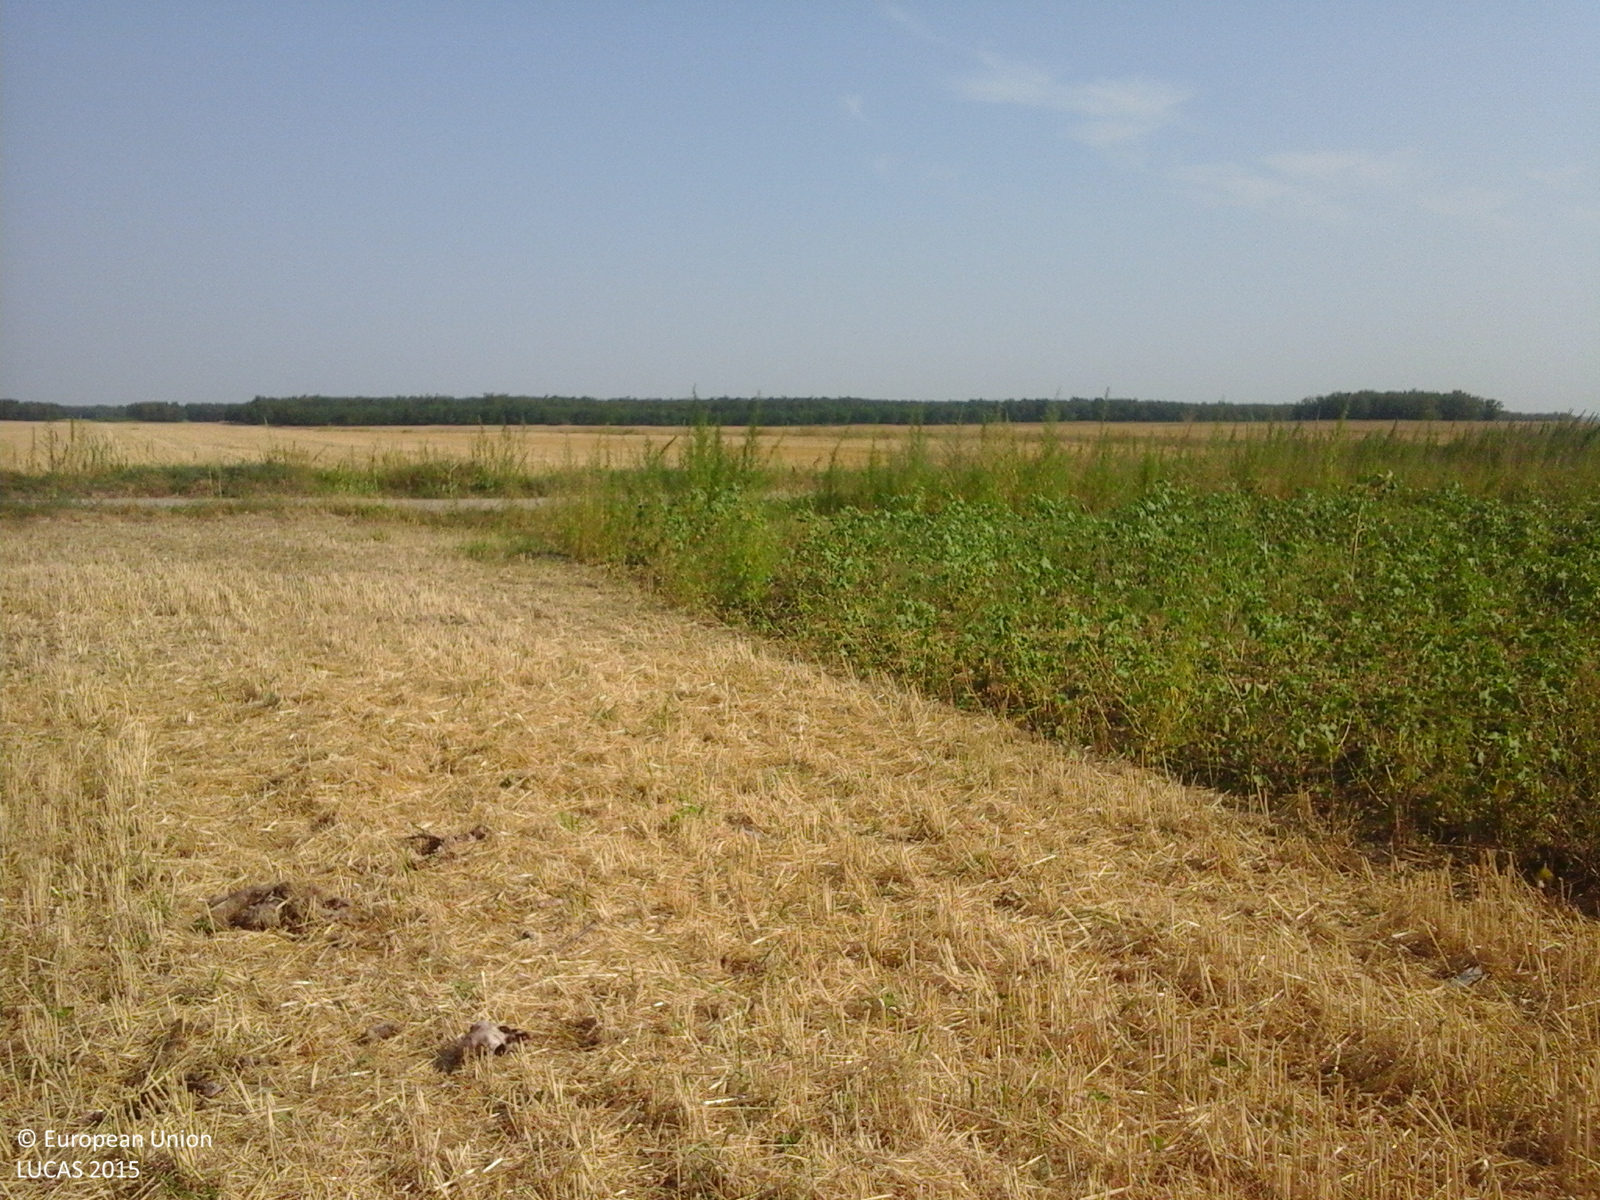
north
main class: Cropland
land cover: Common wheat
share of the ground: > 75 %
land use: Agriculture (excluding fallow land and kitchen gardens)
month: August
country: RO
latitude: 45.7336
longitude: 27.5444
